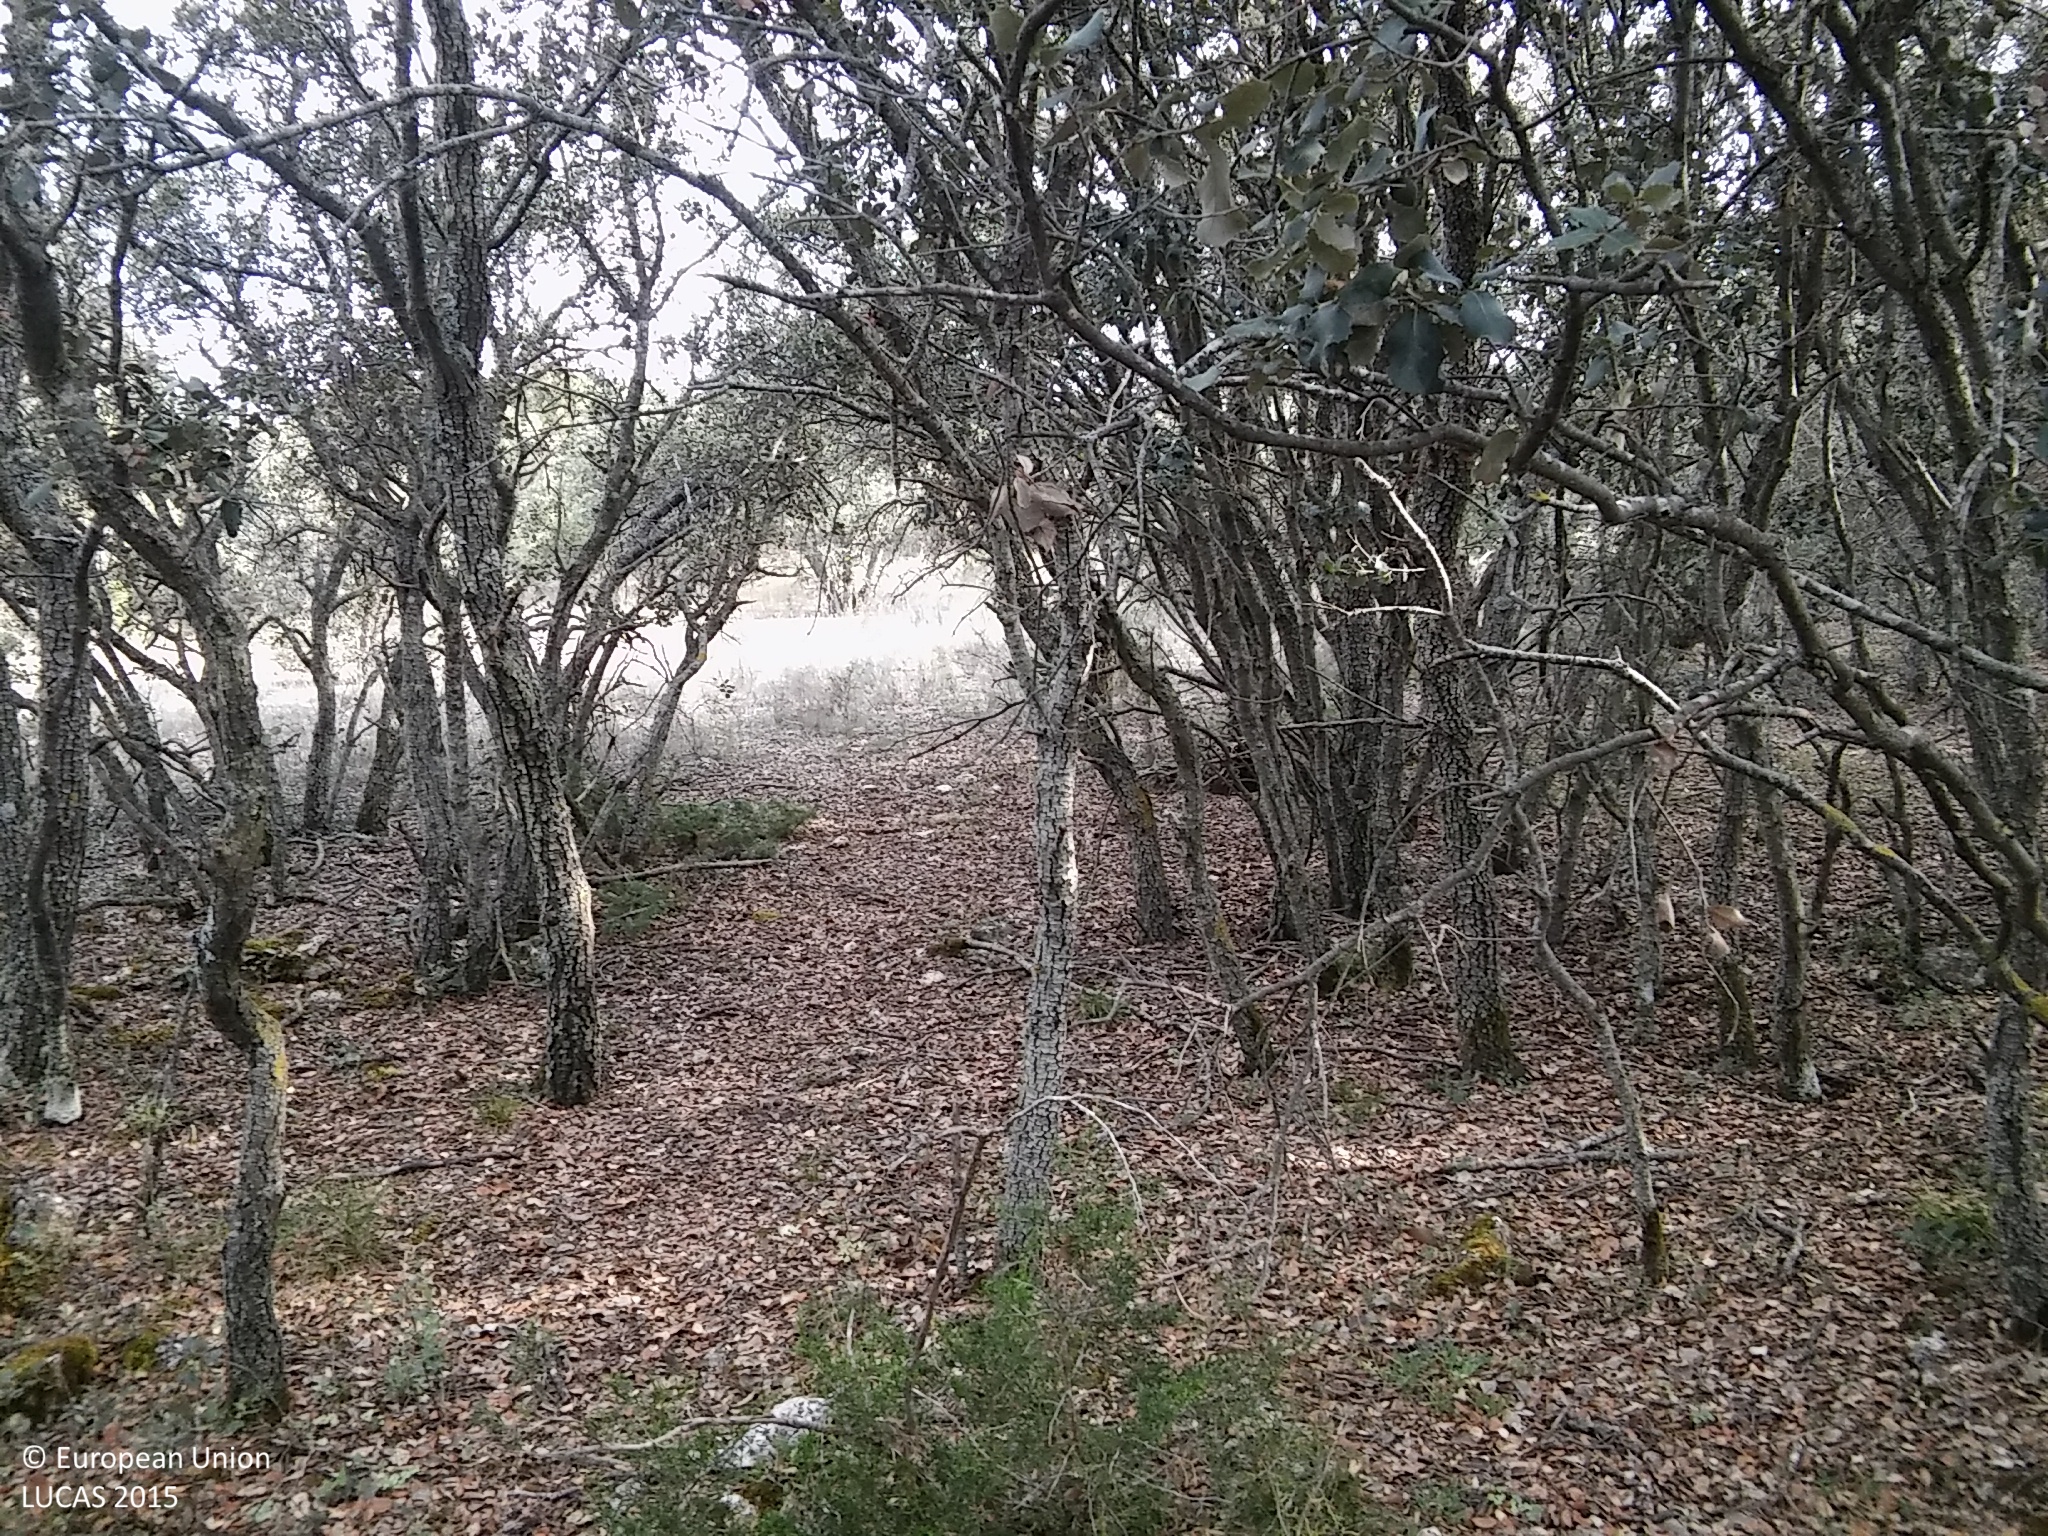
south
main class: Woodland
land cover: Broadleaved woodland
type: broadleaved evergreen forest
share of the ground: 50 - 75 %
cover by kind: broadleaved forest trees 70 %, unconsolidated bare surface 25 %, herbaceous plants 5 %
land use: Semi-natural and natural areas not in use
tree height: > 5 m
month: July
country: ES
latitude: 41.5720
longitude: -3.5657
